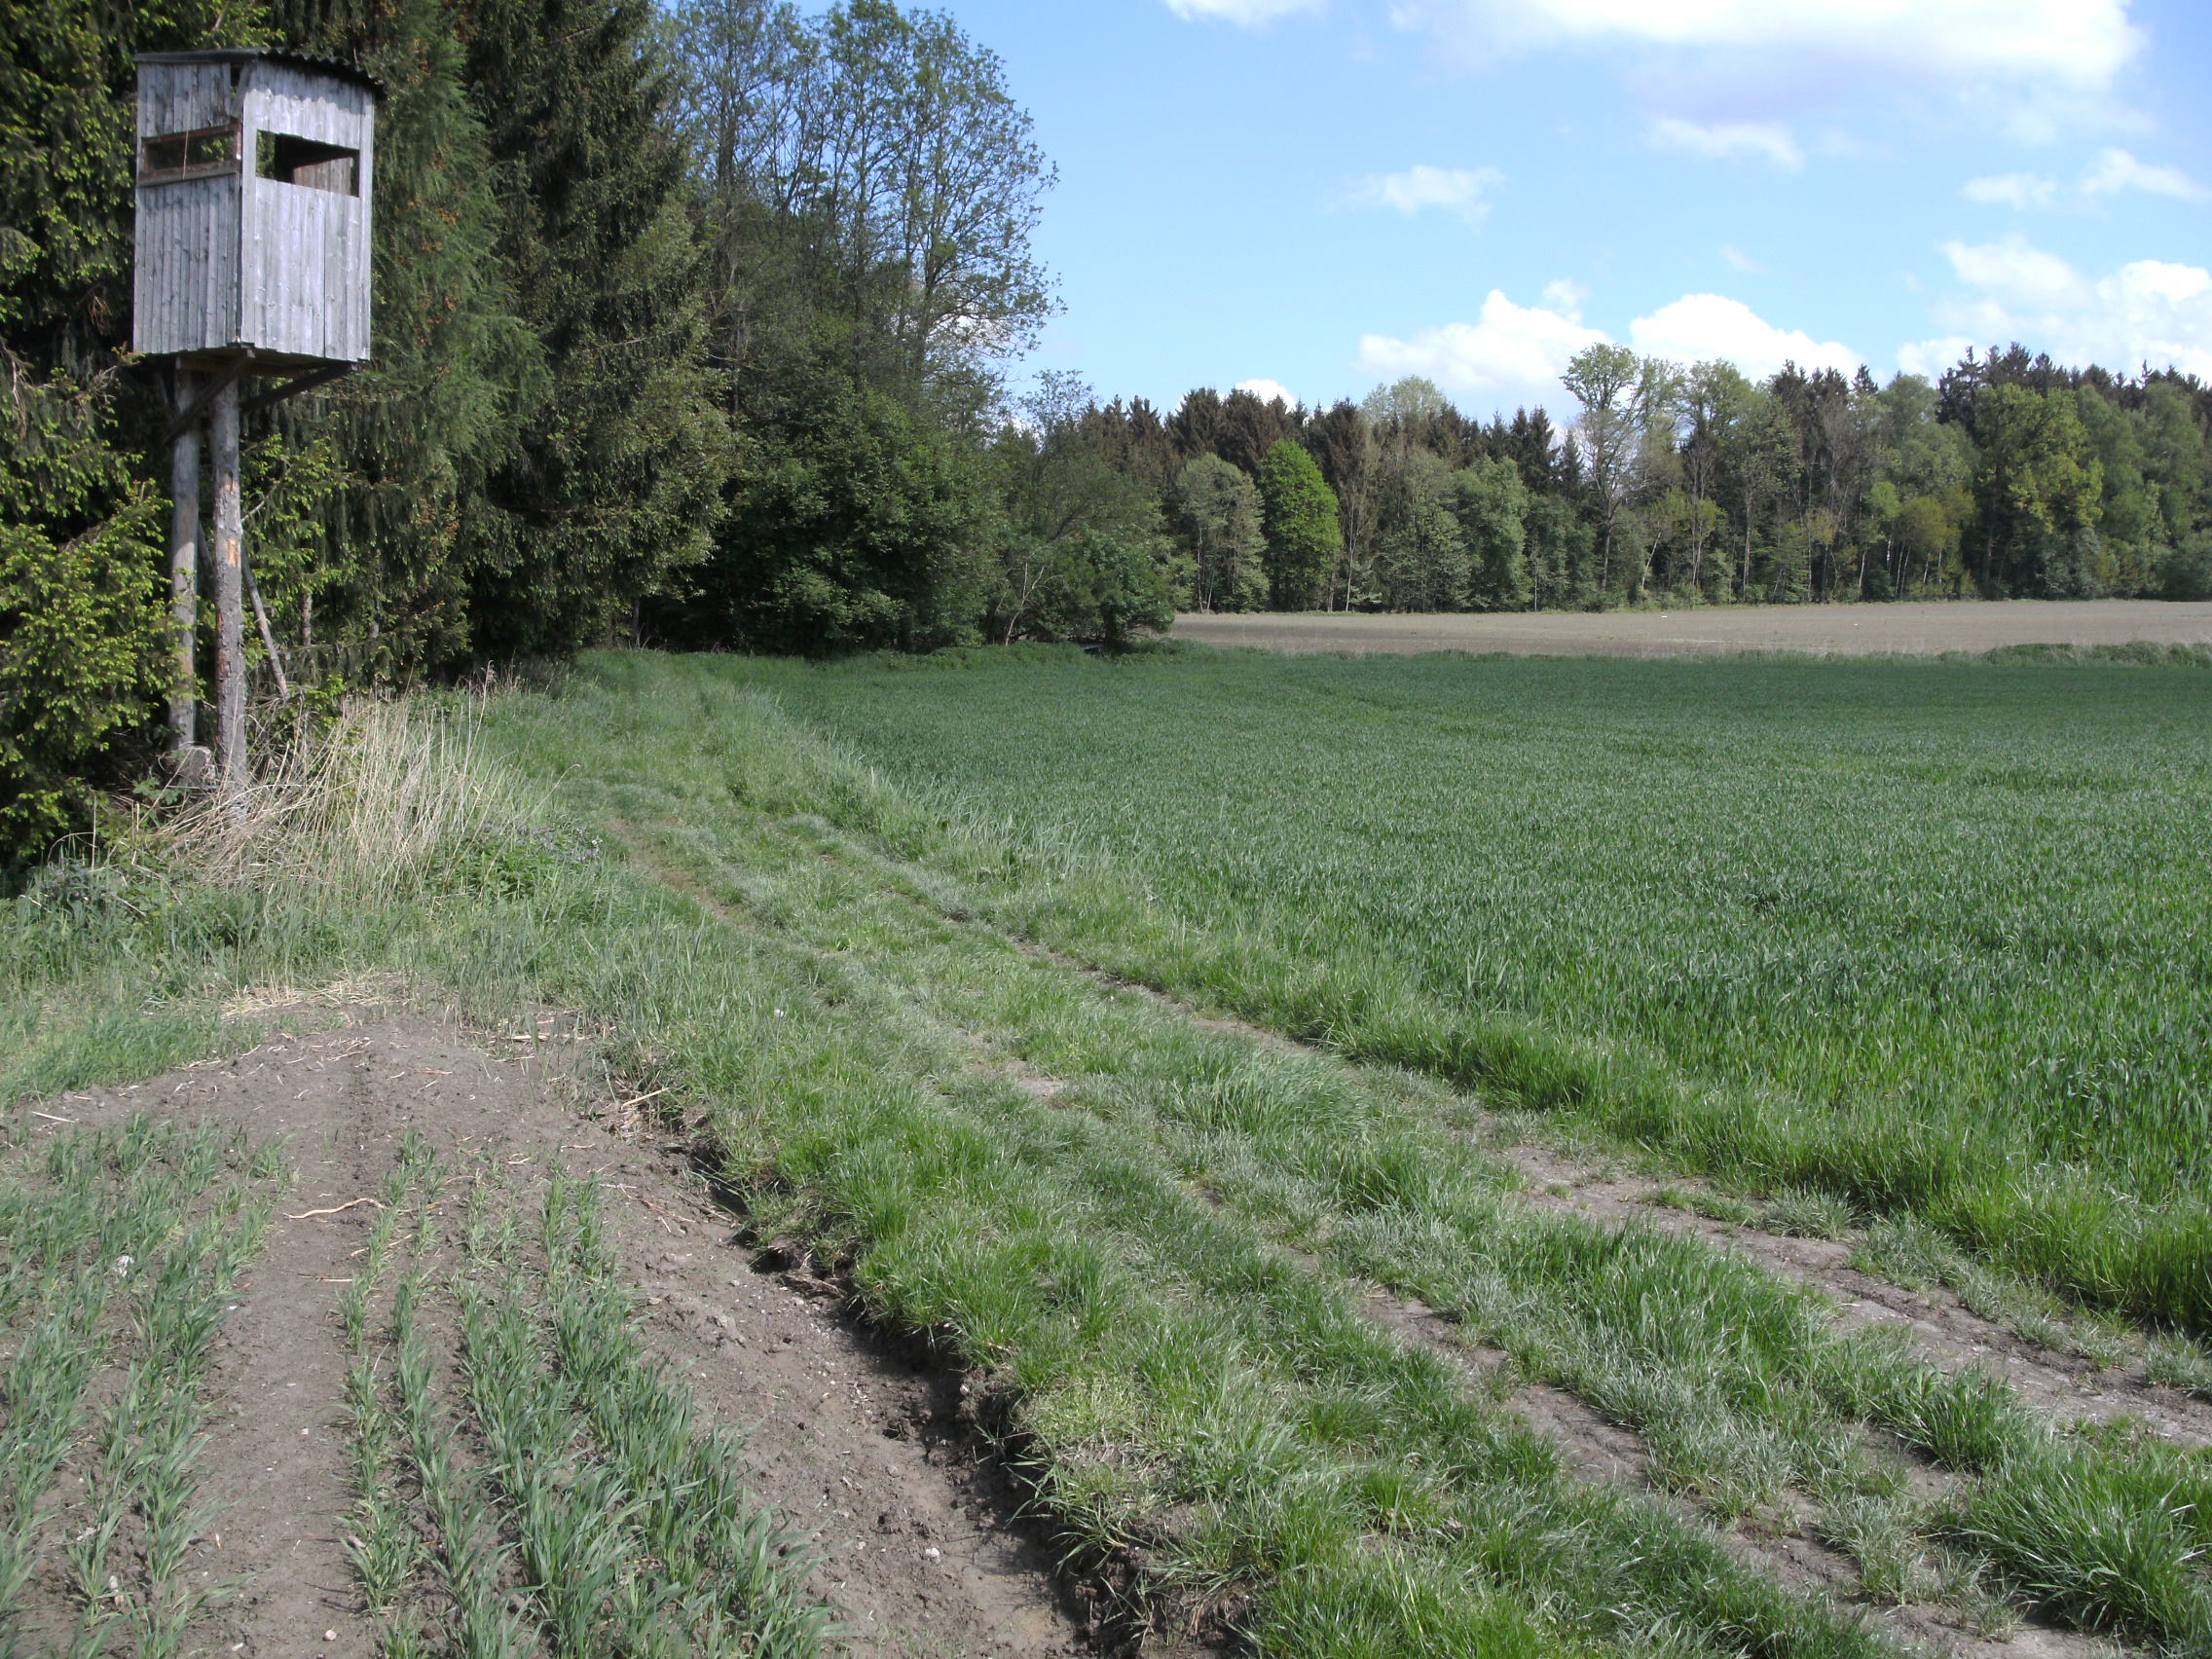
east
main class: Cropland
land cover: Oats
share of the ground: 50 - 75 %
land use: Agriculture (excluding fallow land and kitchen gardens)
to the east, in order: Oats; Spruce dominated coniferous woodland; Tracks; Spruce dominated coniferous woodland; Inland fresh running water; Spruce dominated coniferous woodland; Spruce dominated mixed woodland; Spruce dominated coniferous woodland; Spruce dominated mixed woodland; Broadleaved woodland; Spruce dominated mixed woodland; Rivers and streams; Spruce dominated coniferous woodland; Tracks; Ditches and canals; Spruce dominated coniferous woodland
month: May
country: AT
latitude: 48.2935
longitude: 13.5174
